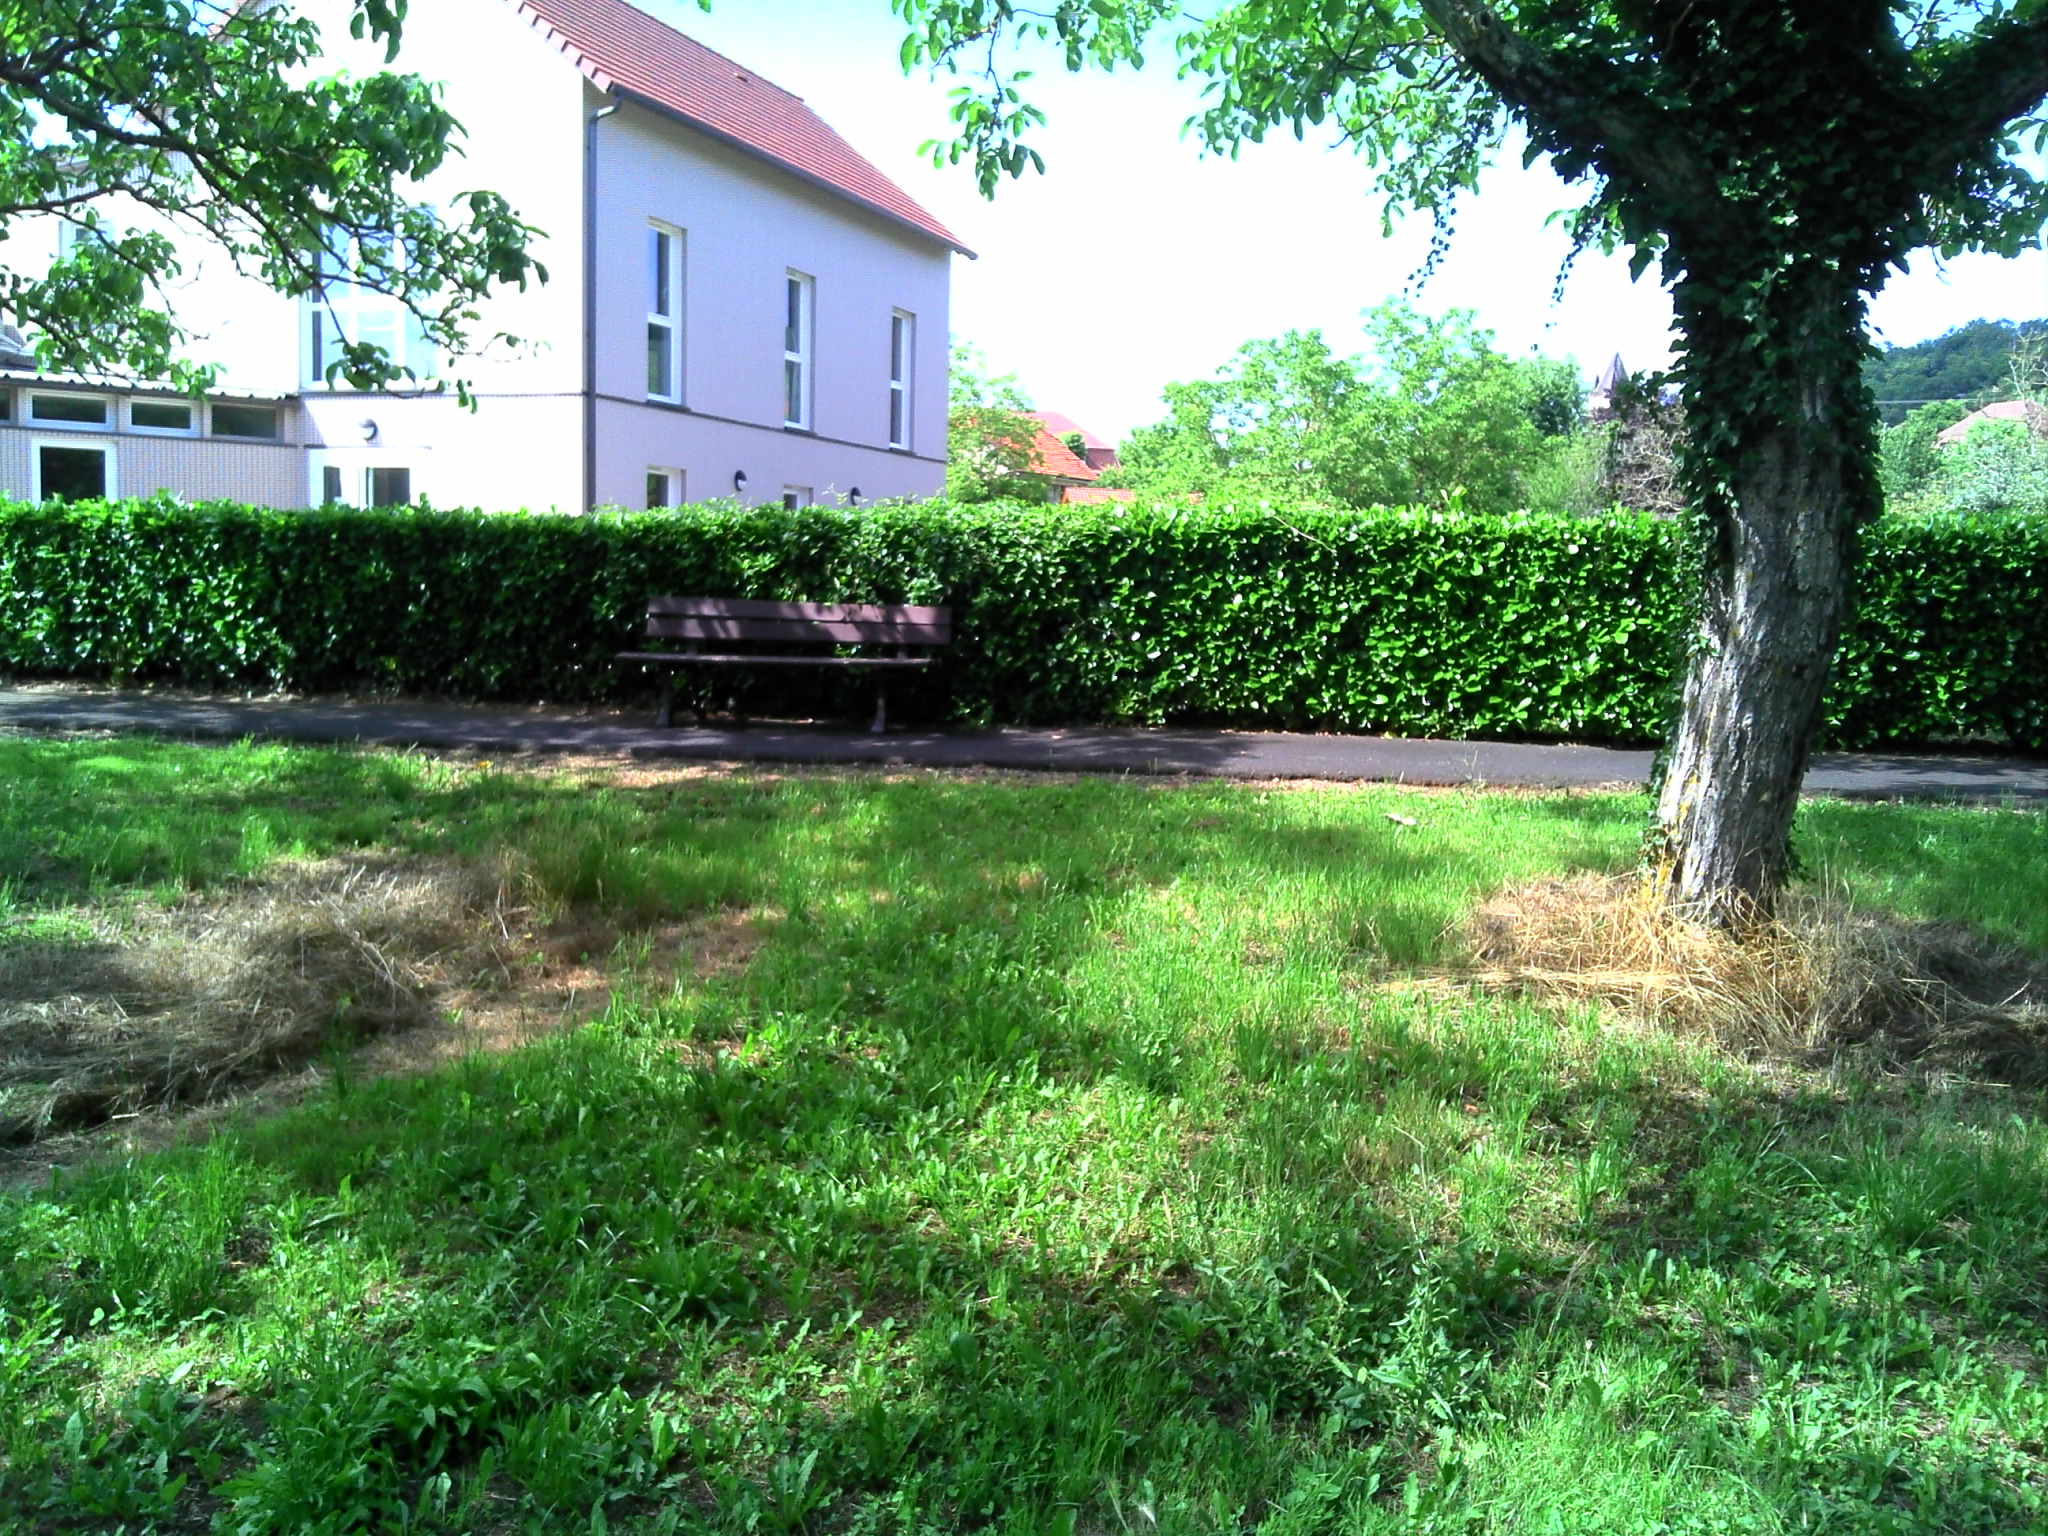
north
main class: Cropland
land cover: Nuts trees
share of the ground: > 75 %
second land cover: Grassland without tree/shrub cover
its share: 10 - 25 %
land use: Agriculture (excluding fallow land and kitchen gardens)
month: June
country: FR
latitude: 44.9195
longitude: 1.8778
